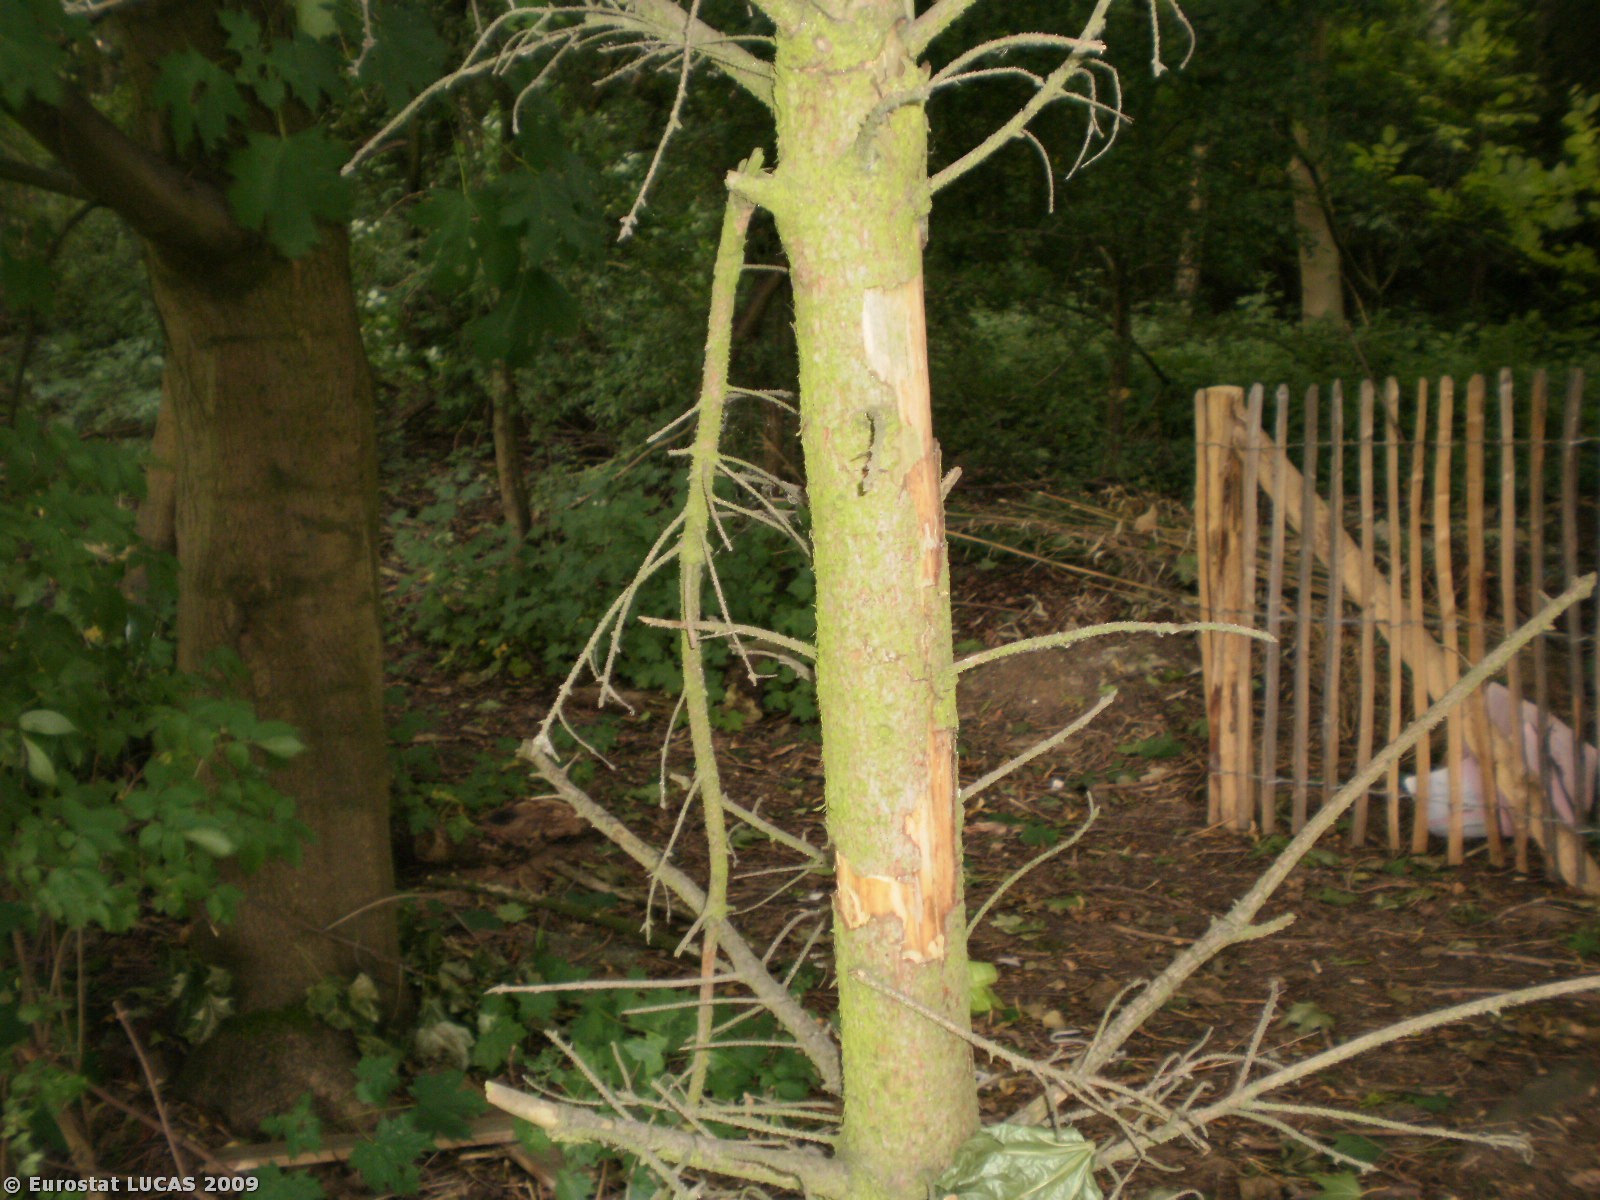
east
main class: Grassland
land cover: Grassland without tree/shrub cover
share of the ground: > 75 %
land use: Agriculture (excluding fallow land and kitchen gardens)
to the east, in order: Grassland without tree/shrub cover; Fences; Broadleaved woodland; Paved roads, cycling and walking lanes; Broadleaved woodland; Bare land; Fences; Paved roads, cycling and walking lanes; Artificial constructions in urban areas
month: July
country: BE
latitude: 50.8693
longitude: 4.2685
